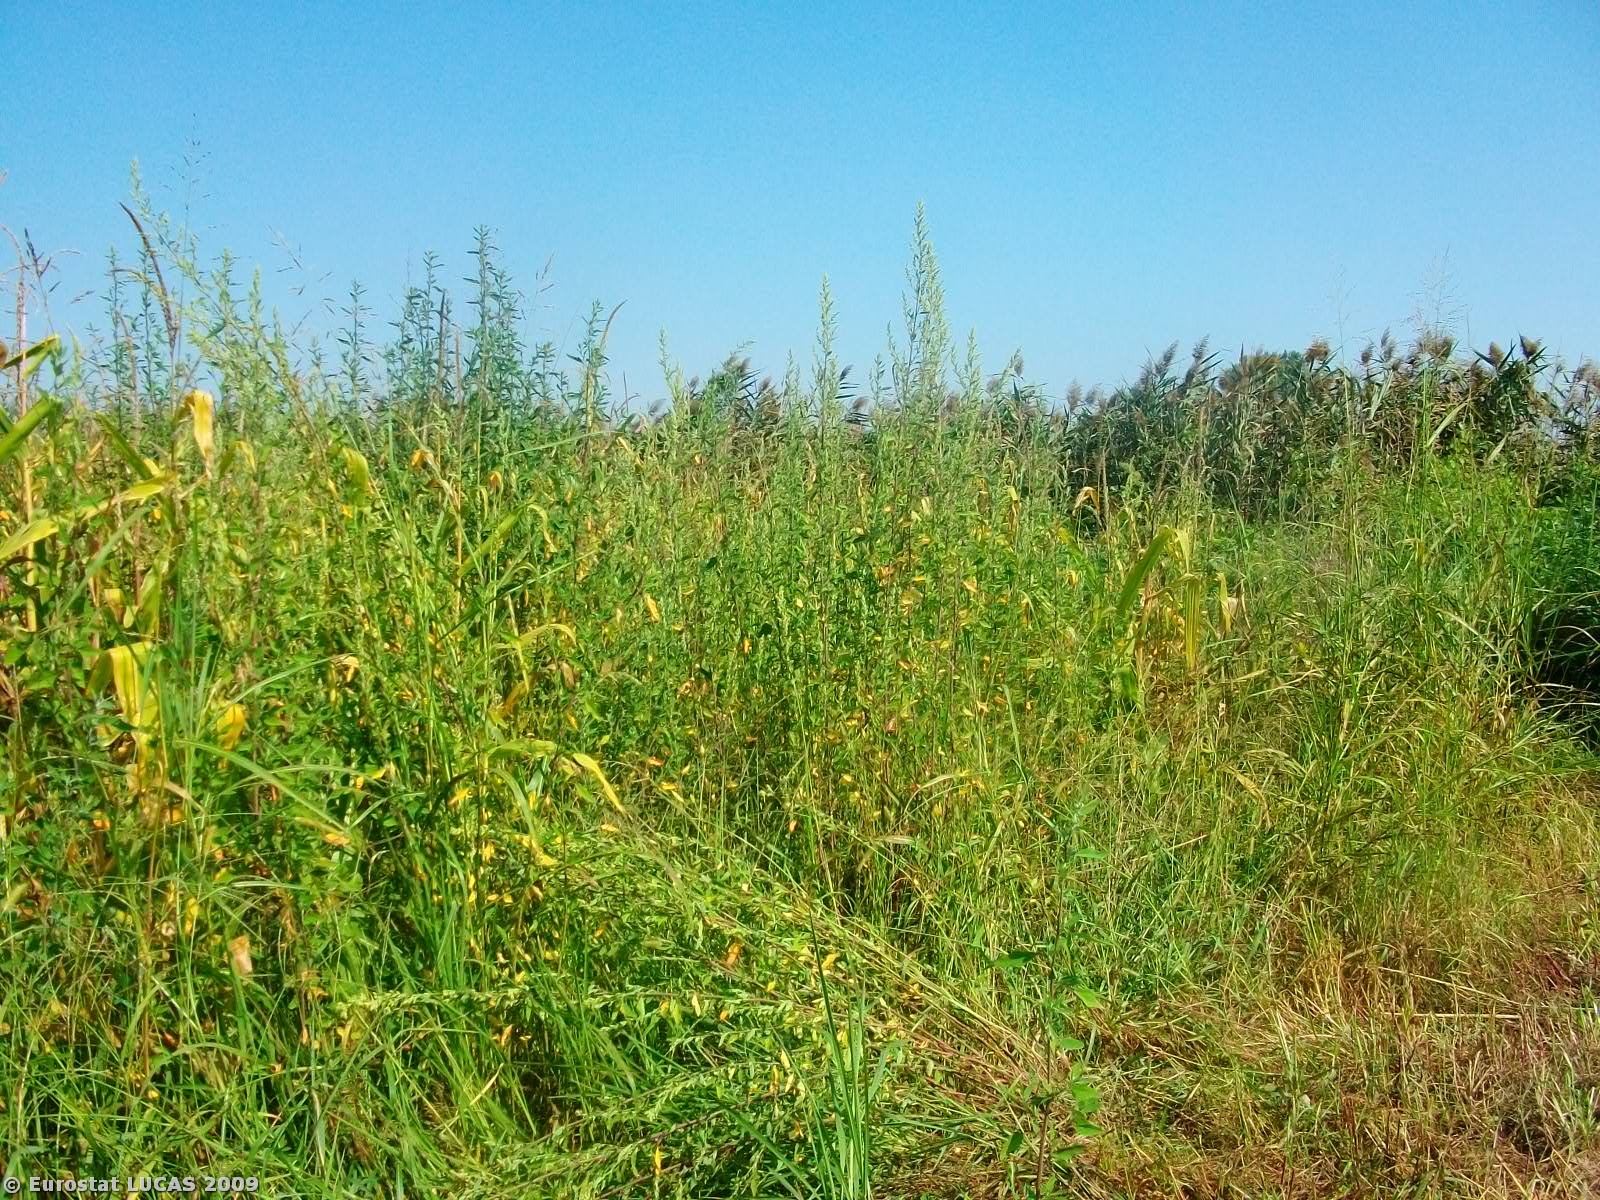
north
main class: Cropland
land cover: Maize
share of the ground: > 75 %
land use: Agriculture (excluding fallow land and kitchen gardens)
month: August
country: GR
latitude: 40.6579
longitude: 22.7434
